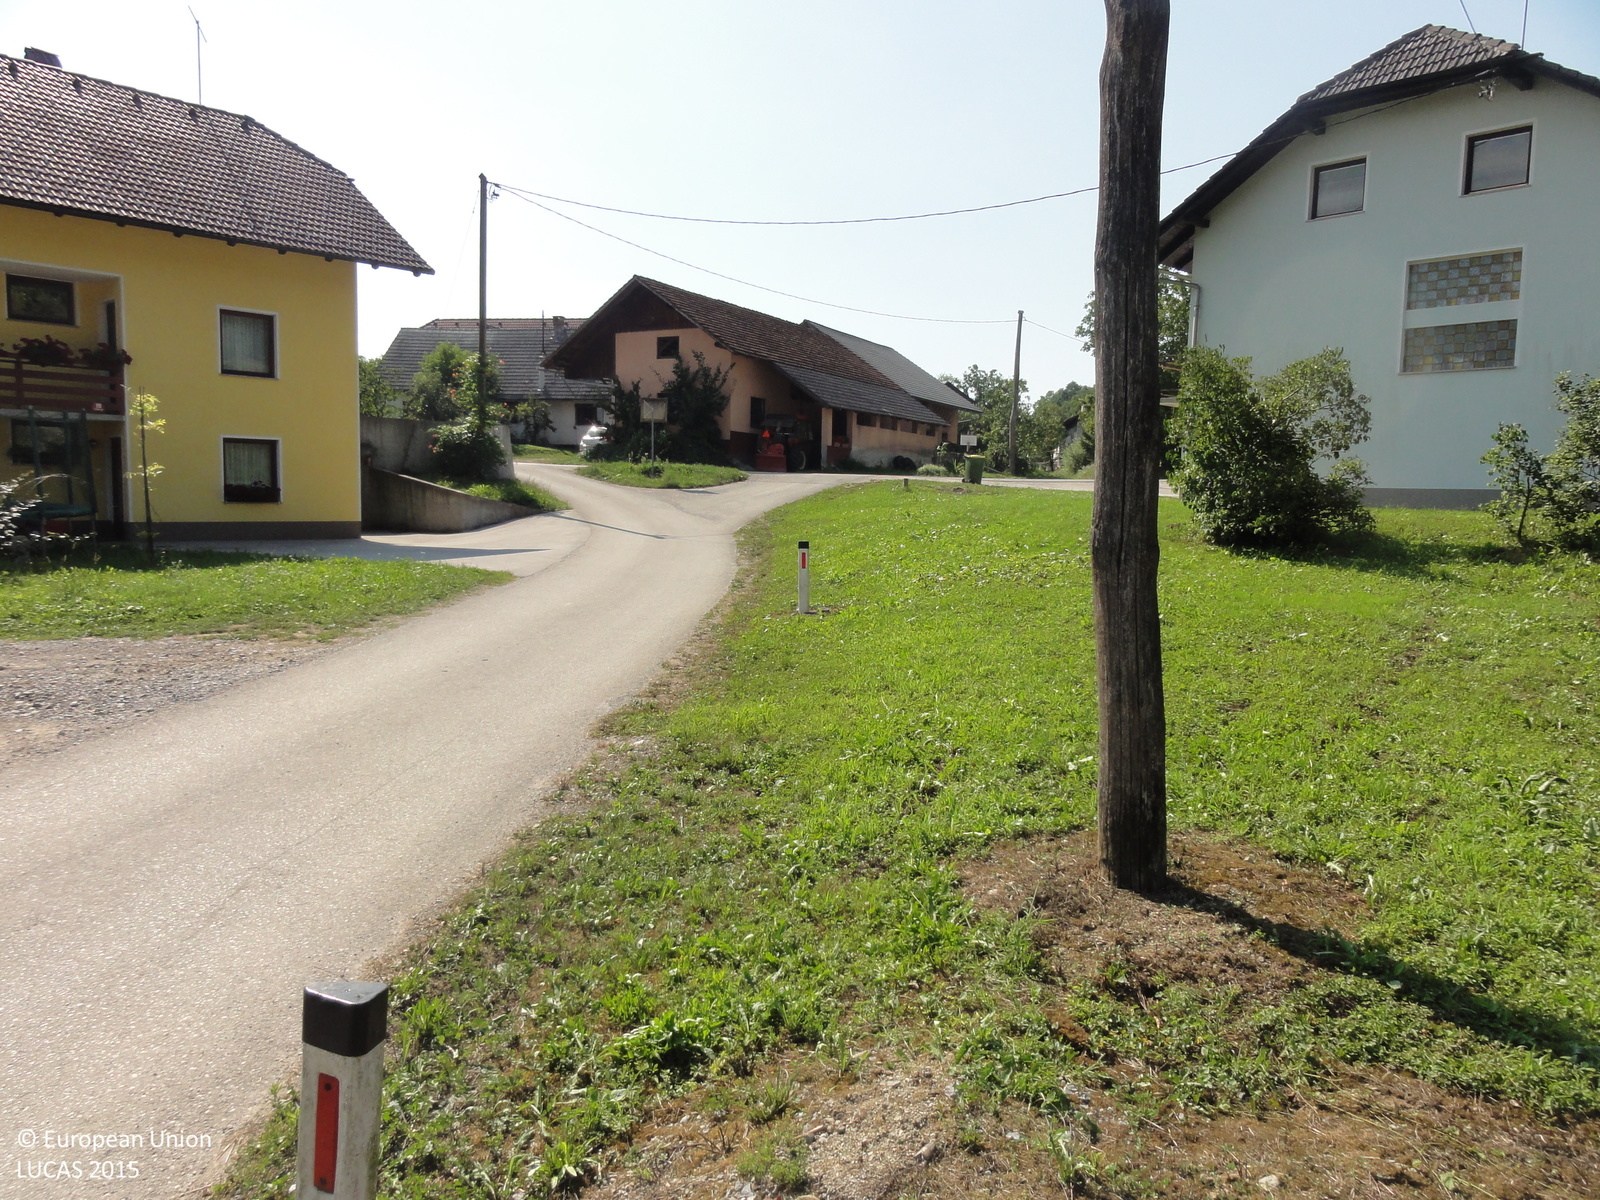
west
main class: Grassland
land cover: Grassland without tree/shrub cover
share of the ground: 50 - 75 %
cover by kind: herbaceous plants 60 %
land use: Residential
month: August
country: SI
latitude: 45.9065
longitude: 15.0627
